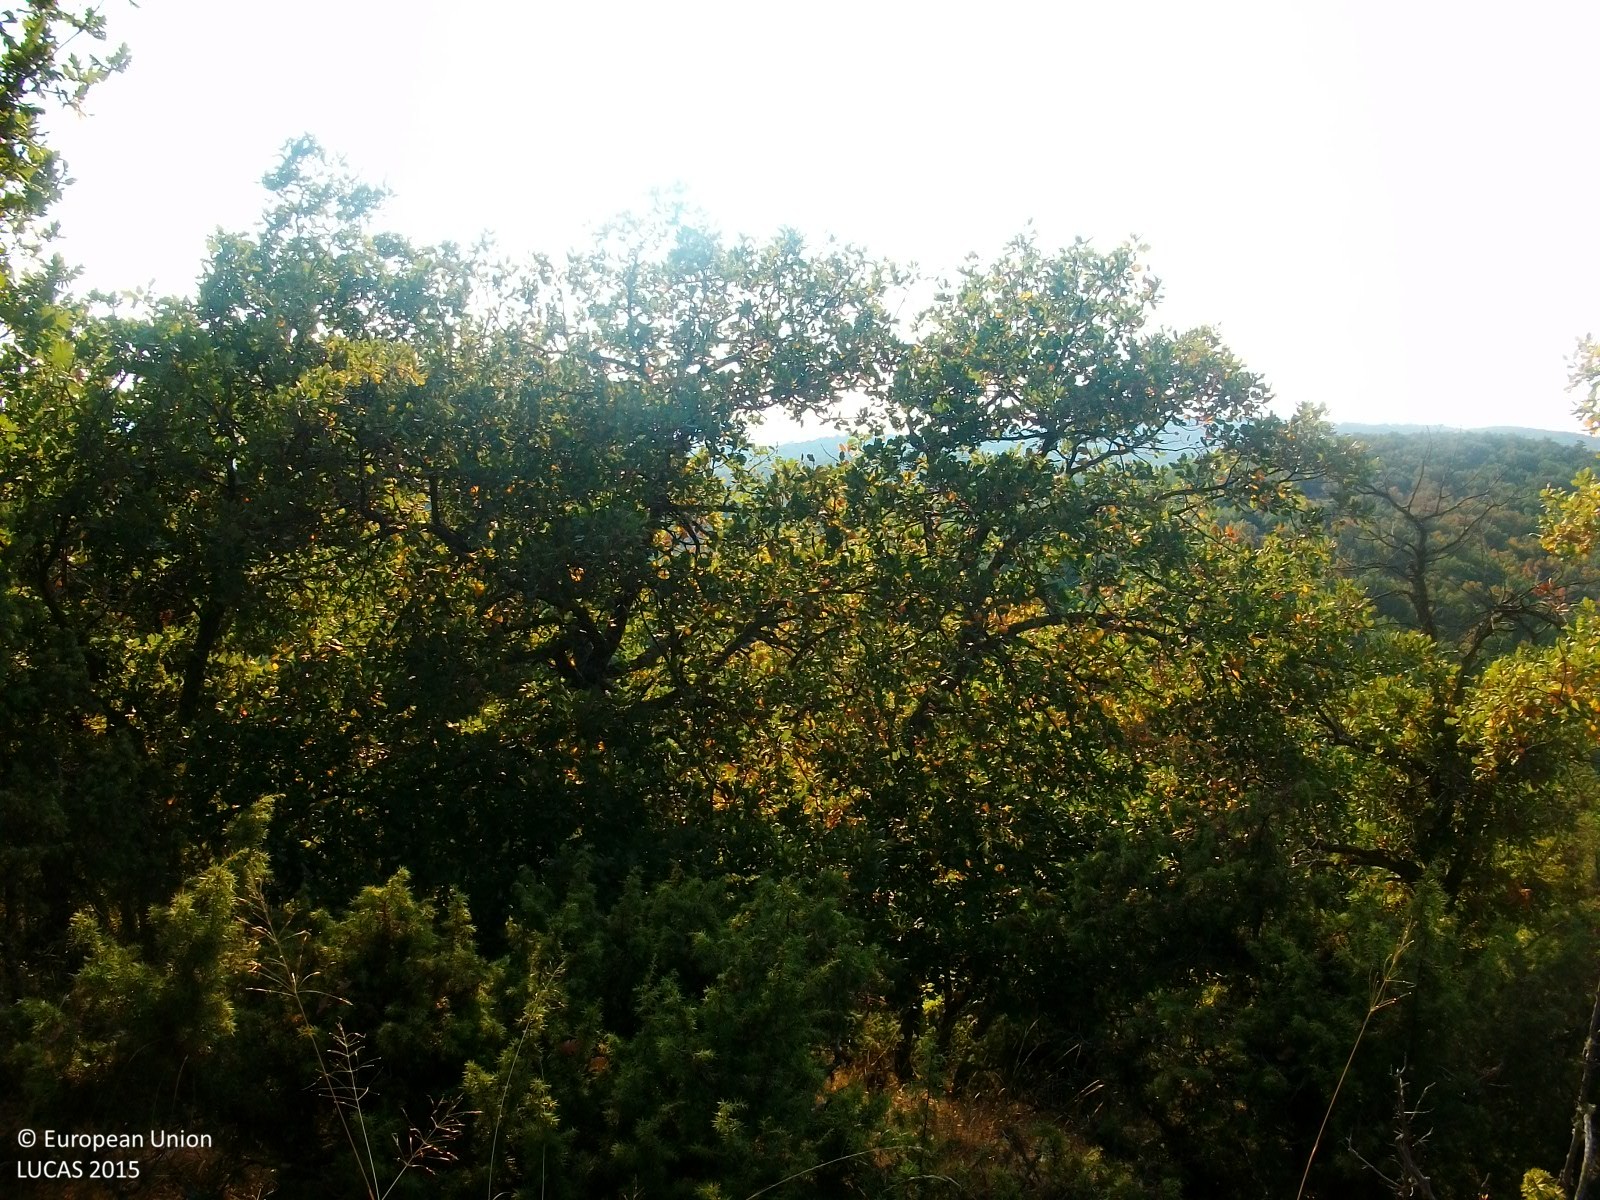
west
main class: Woodland
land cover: Broadleaved woodland
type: thermophilous deciduous forest
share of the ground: > 75 %
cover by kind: broadleaved forest trees 100 %
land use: Forestry
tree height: > 5 m
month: July
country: GR
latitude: 41.3291
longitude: 26.0409
